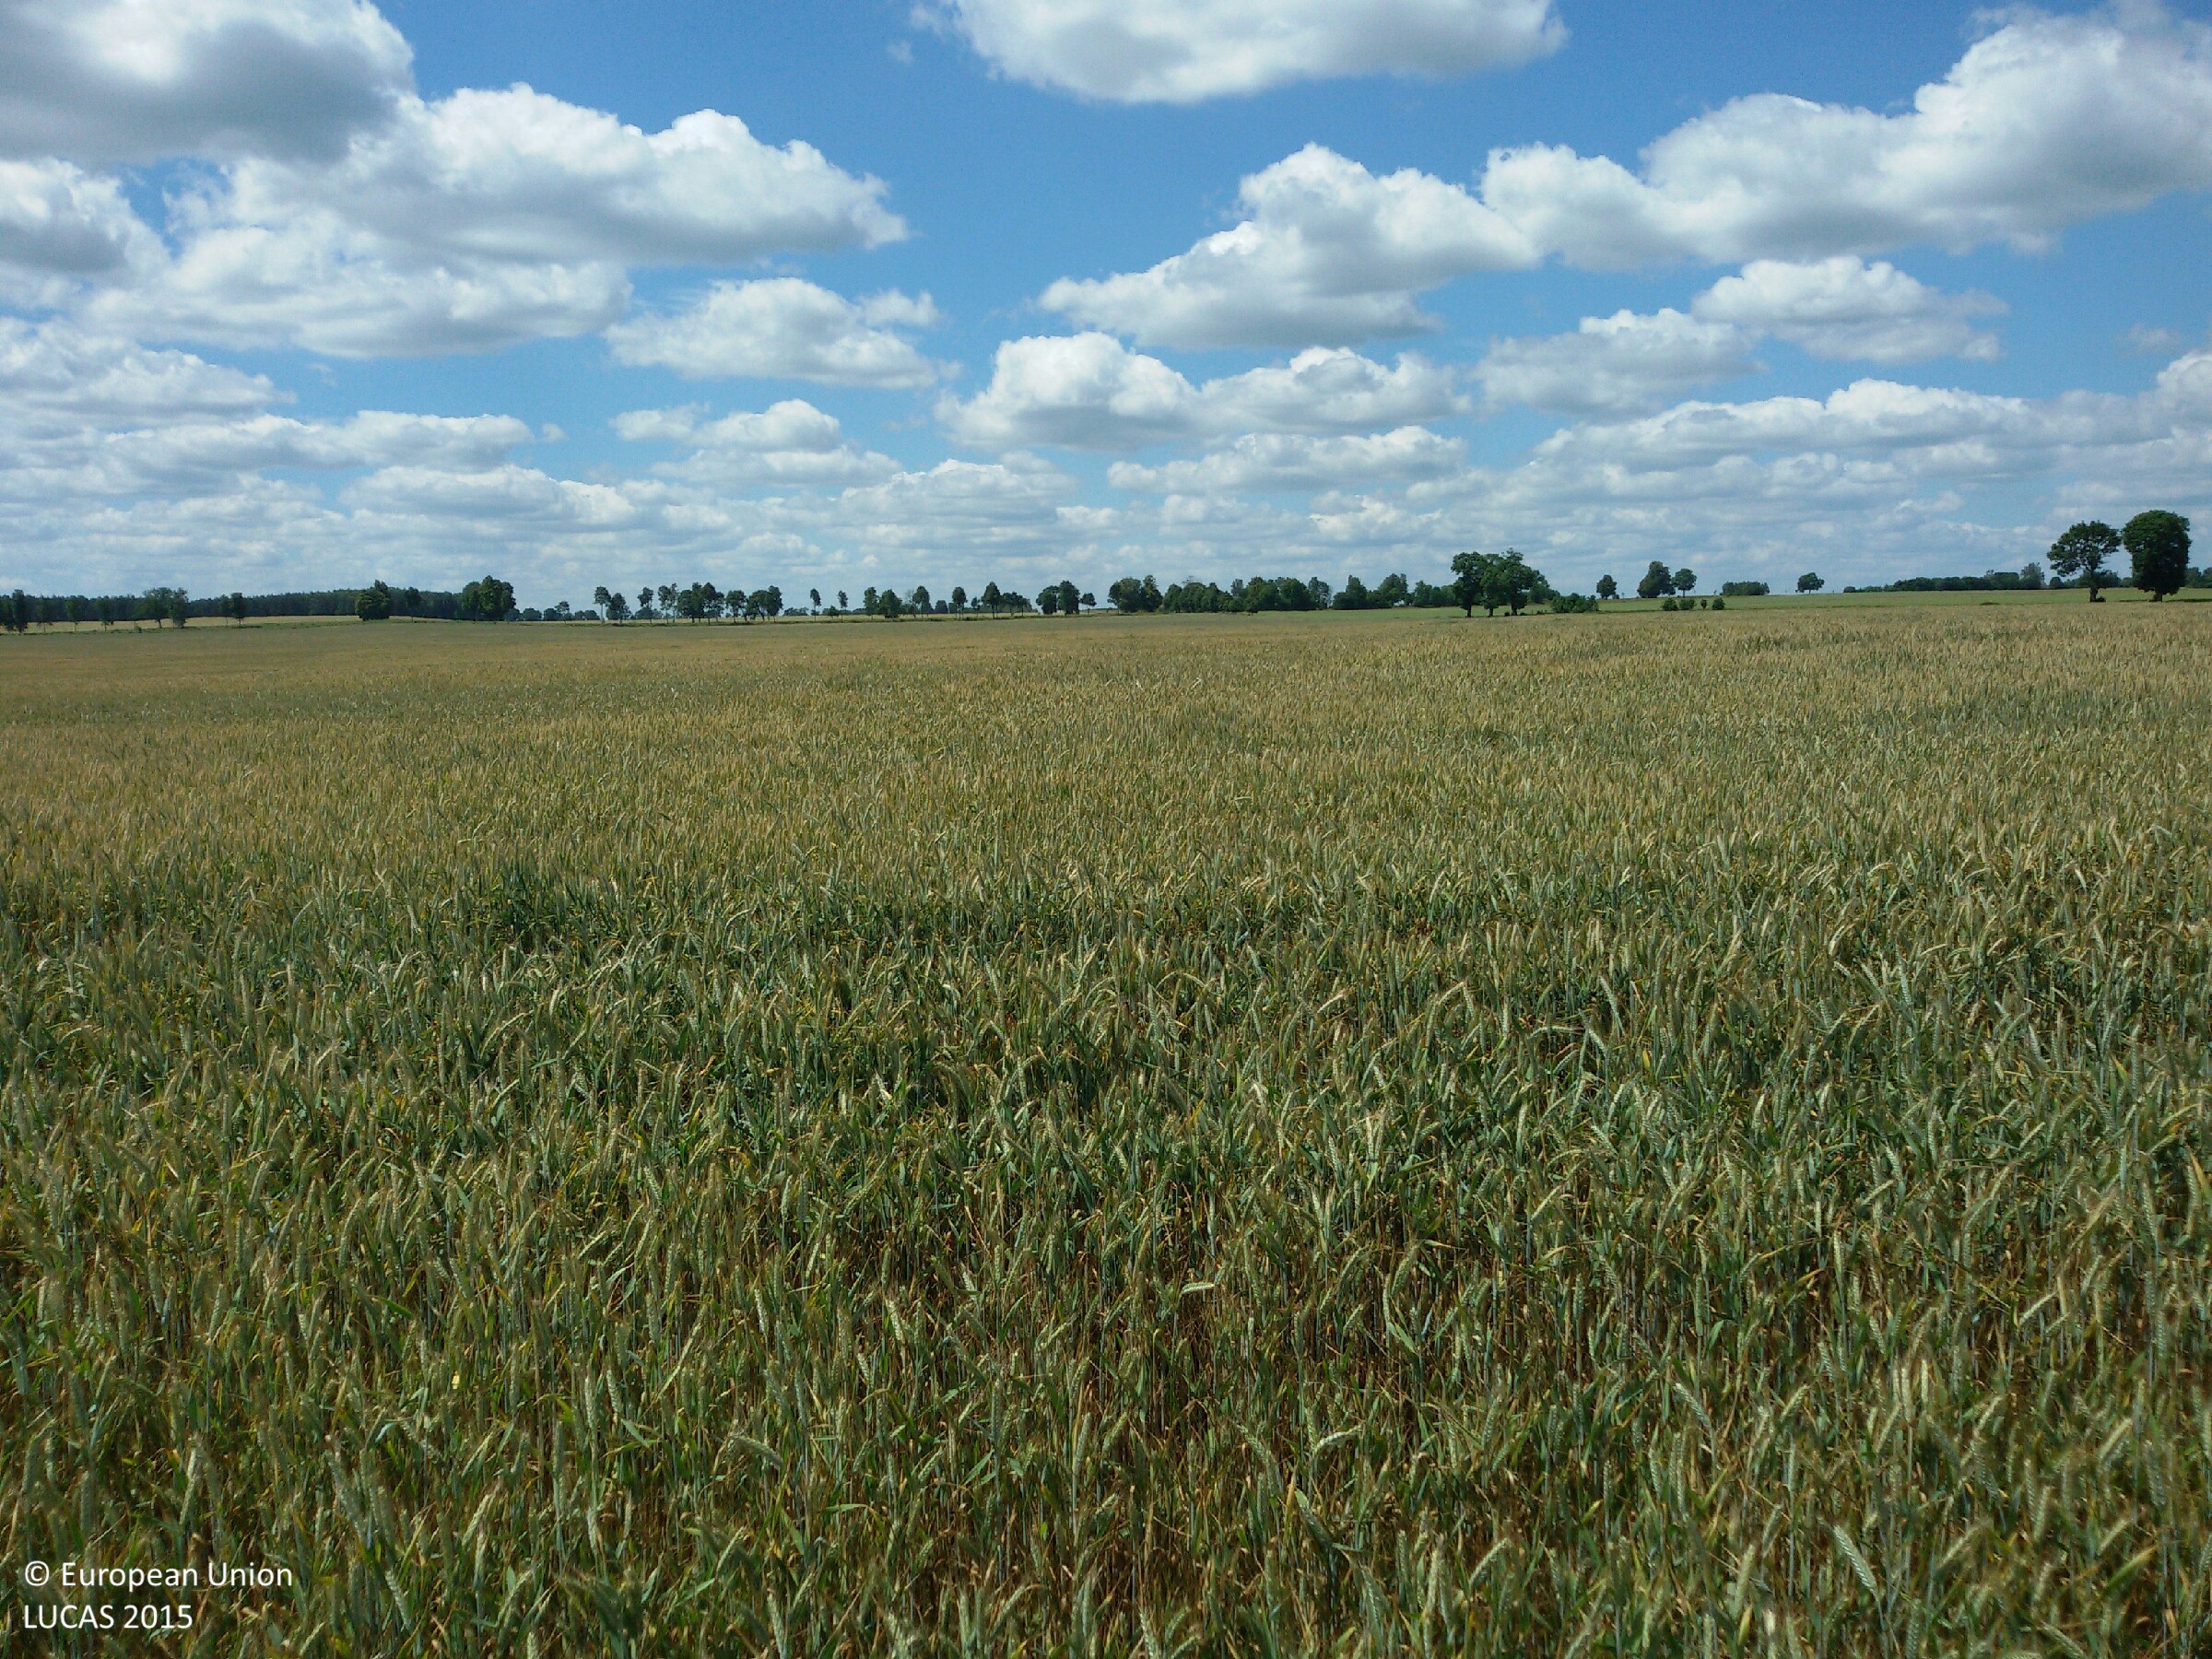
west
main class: Cropland
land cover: Common wheat
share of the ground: > 75 %
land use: Agriculture (excluding fallow land and kitchen gardens)
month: July
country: PL
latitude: 53.3757
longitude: 20.1192
